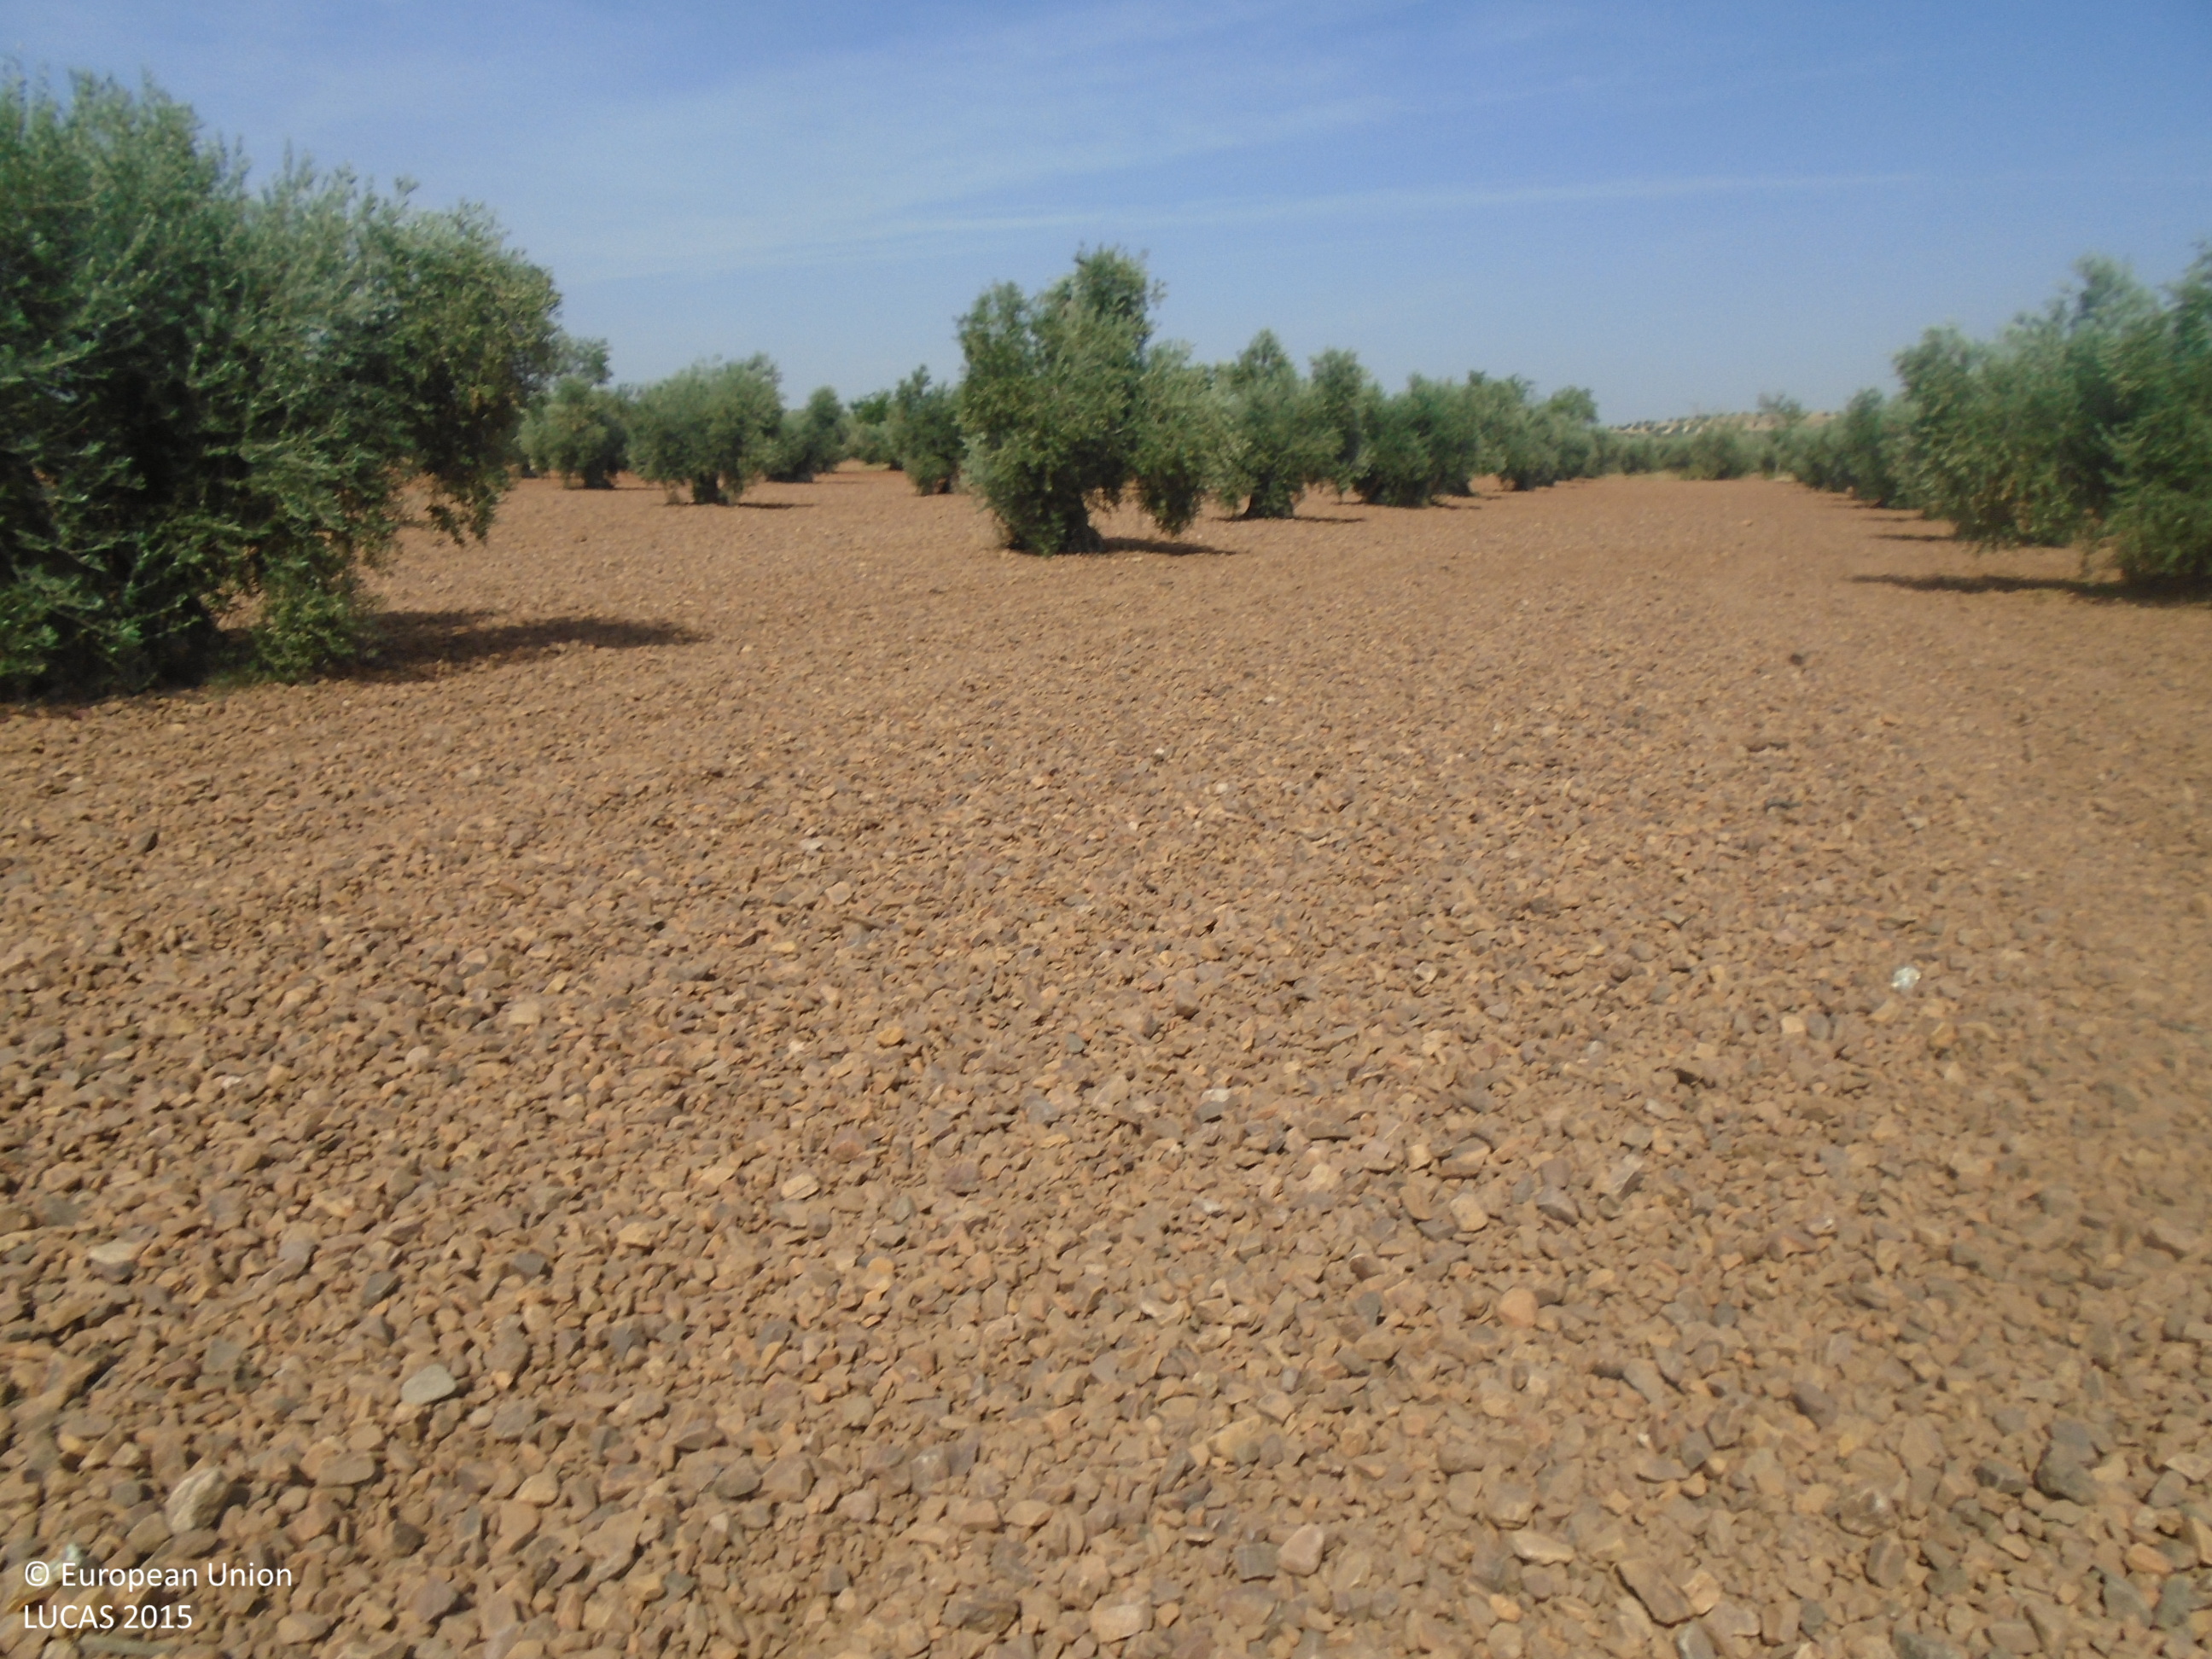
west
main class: Cropland
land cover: Olive groves
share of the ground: 25 - 50 %
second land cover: Other bare soil
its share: > 75 %
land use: Agriculture (excluding fallow land and kitchen gardens)
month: July
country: ES
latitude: 39.4137
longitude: -3.5531
